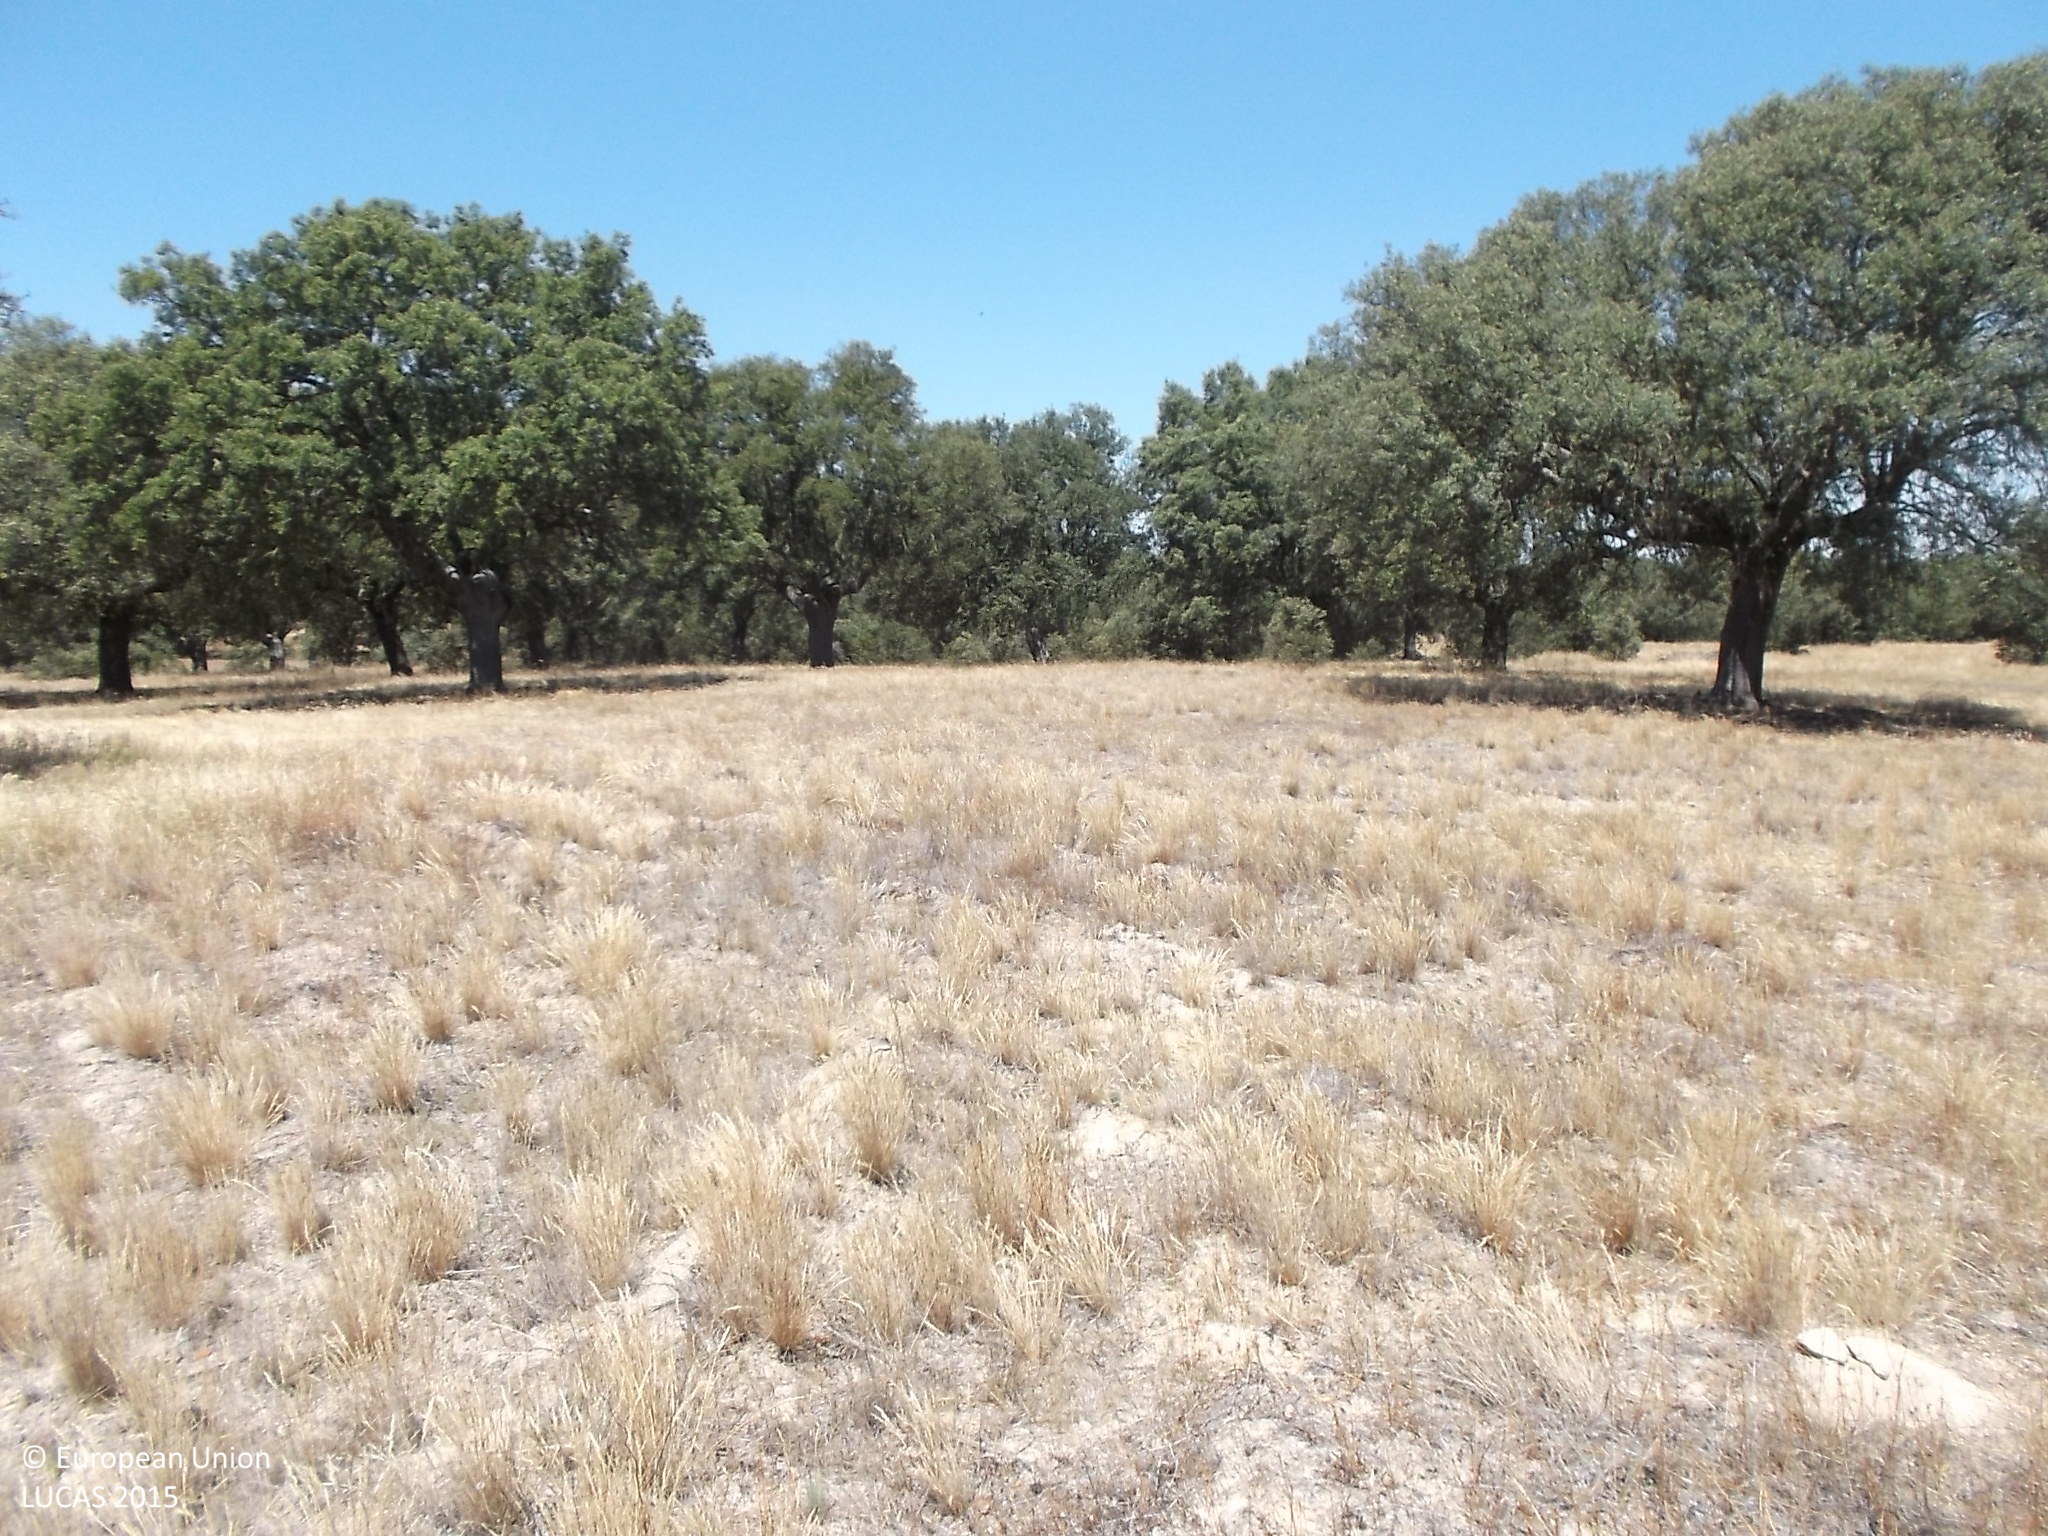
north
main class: Woodland
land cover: Broadleaved woodland
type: broadleaved evergreen forest
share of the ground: 50 - 75 %
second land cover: Grassland without tree/shrub cover
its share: 50 - 75 %
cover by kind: broadleaved forest trees 50 %, herbaceous plants 50 %
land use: Forestry
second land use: Agriculture (excluding fallow land and kitchen gardens)
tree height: < 5 m
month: July
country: ES
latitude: 41.3670
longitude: -5.8067
